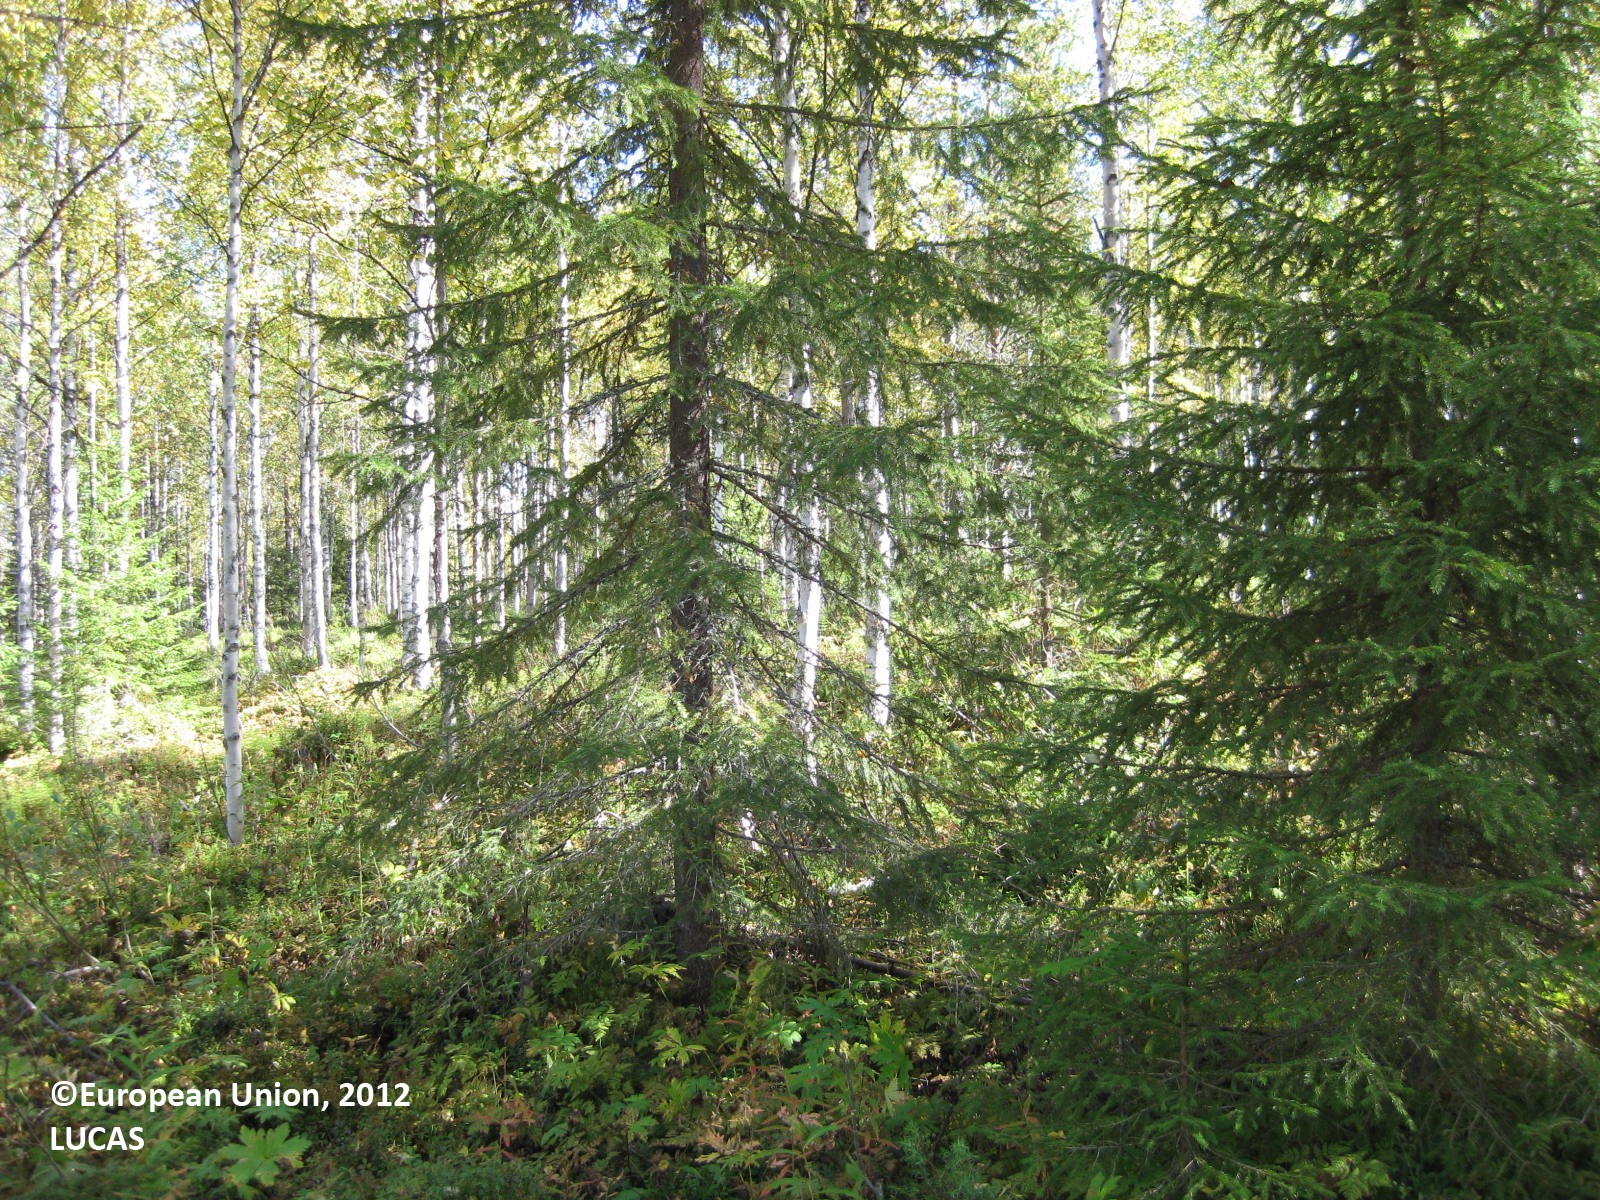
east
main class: Woodland
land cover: Broadleaved woodland
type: boreal forest
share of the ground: 50 - 75 %
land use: Forestry
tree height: > 5 m
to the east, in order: Broadleaved woodland; Other mixed woodland
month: August
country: FI
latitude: 65.8419
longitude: 28.6204
